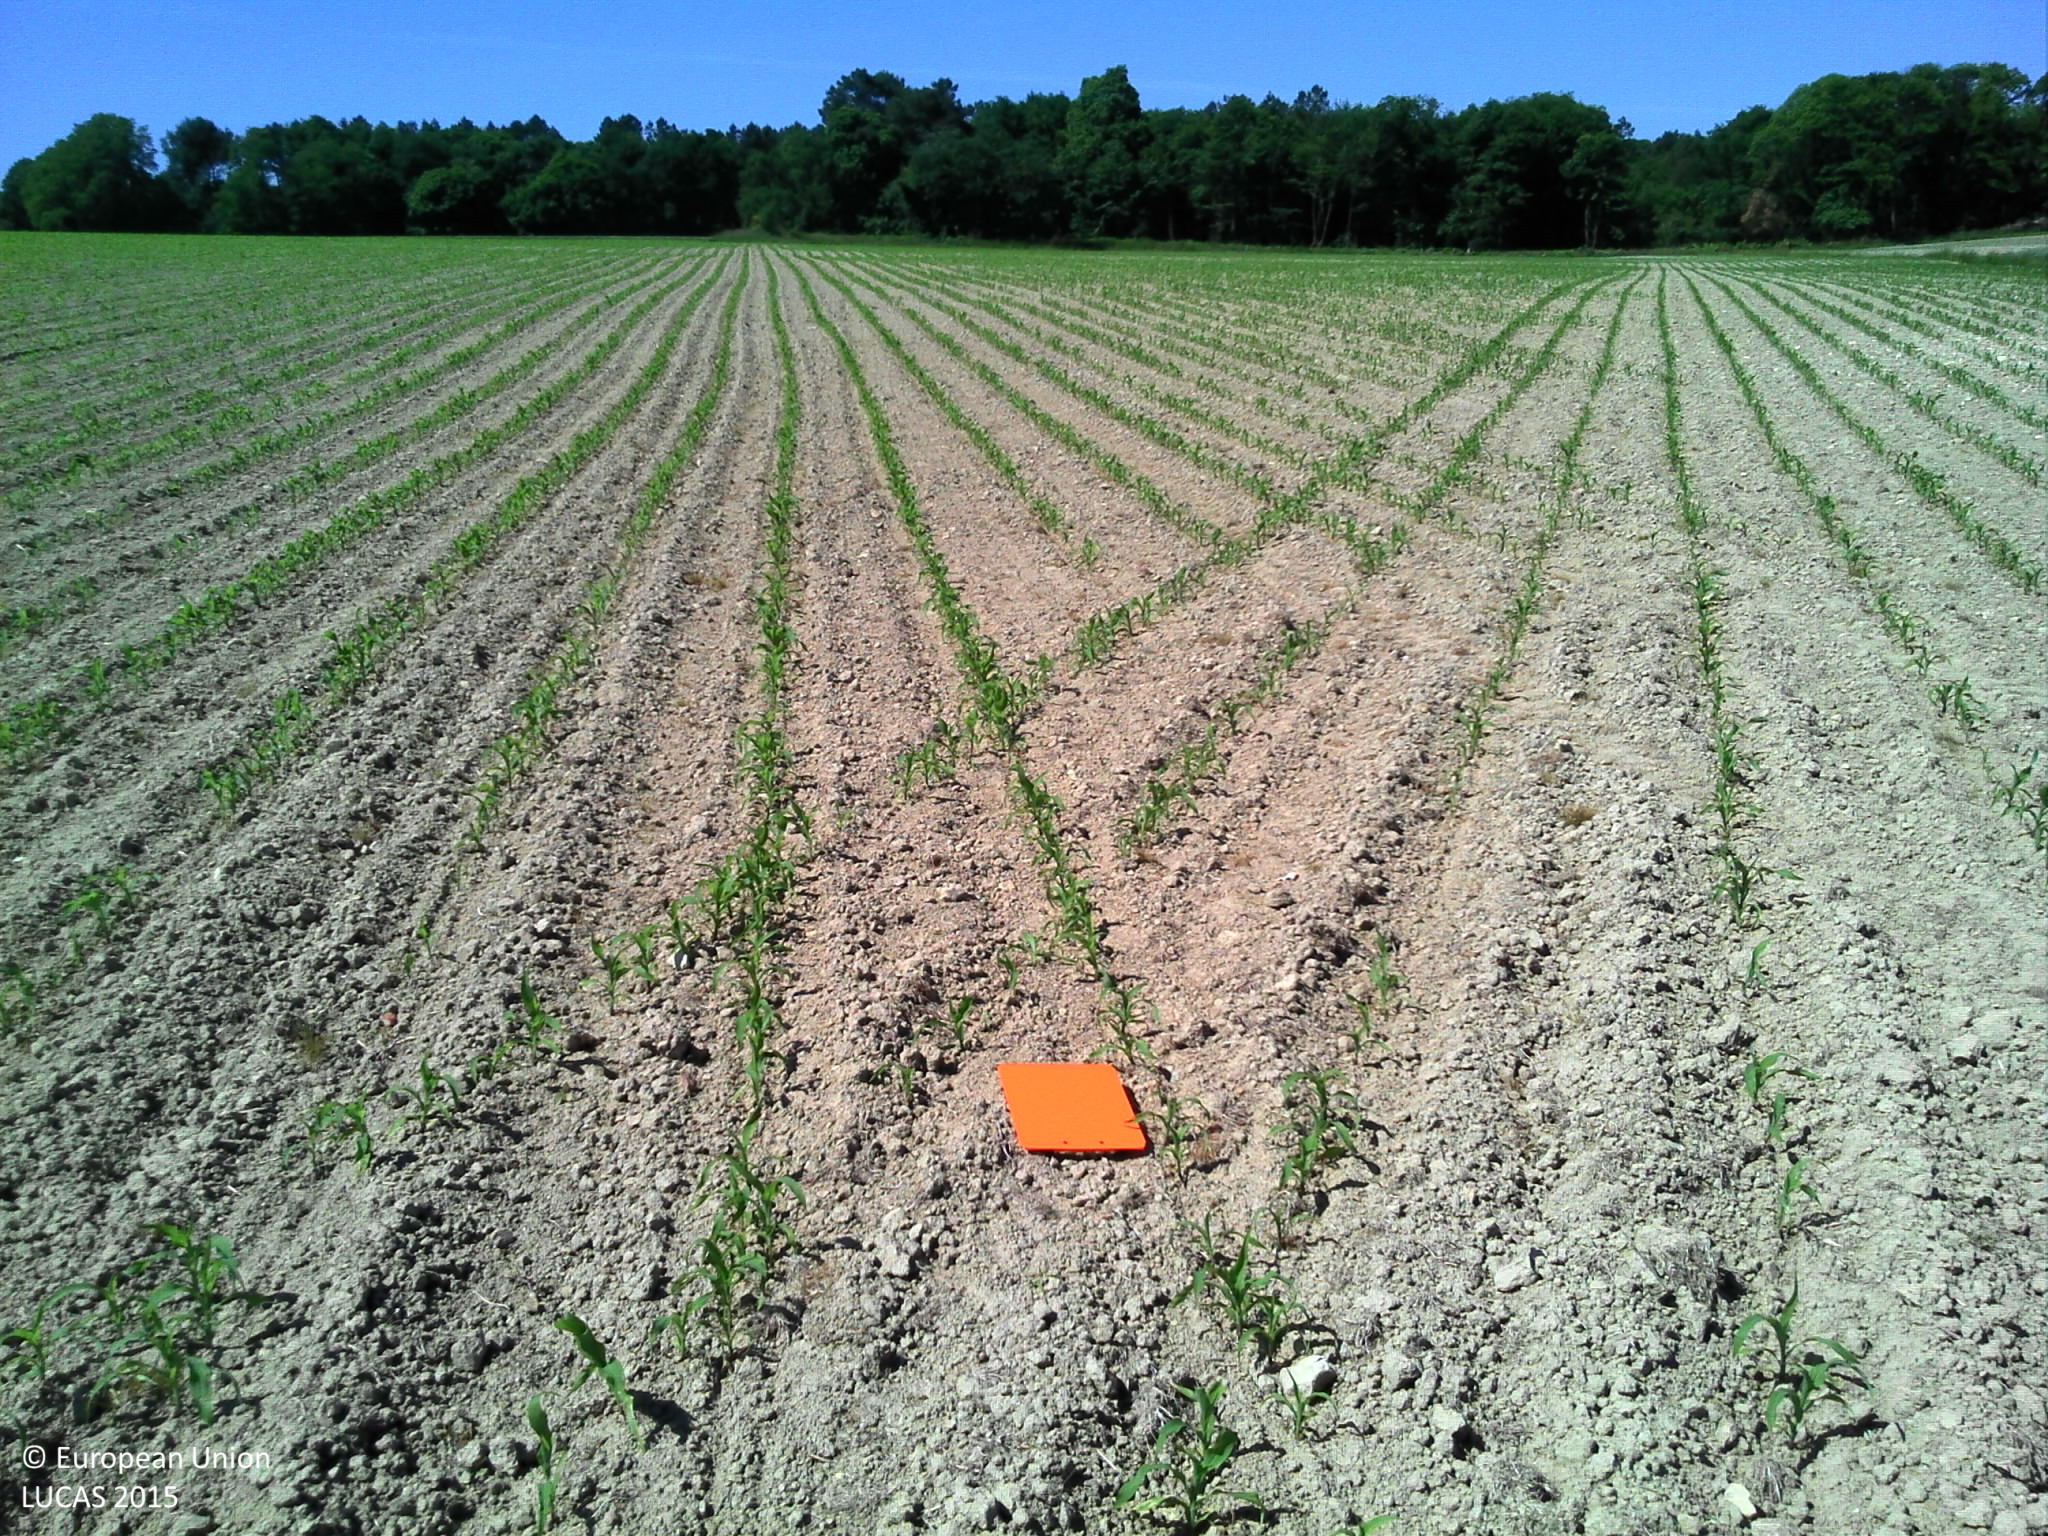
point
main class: Cropland
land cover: Maize
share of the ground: 10 - 25 %
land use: Agriculture (excluding fallow land and kitchen gardens)
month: June
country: FR
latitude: 46.9100
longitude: 0.5413
